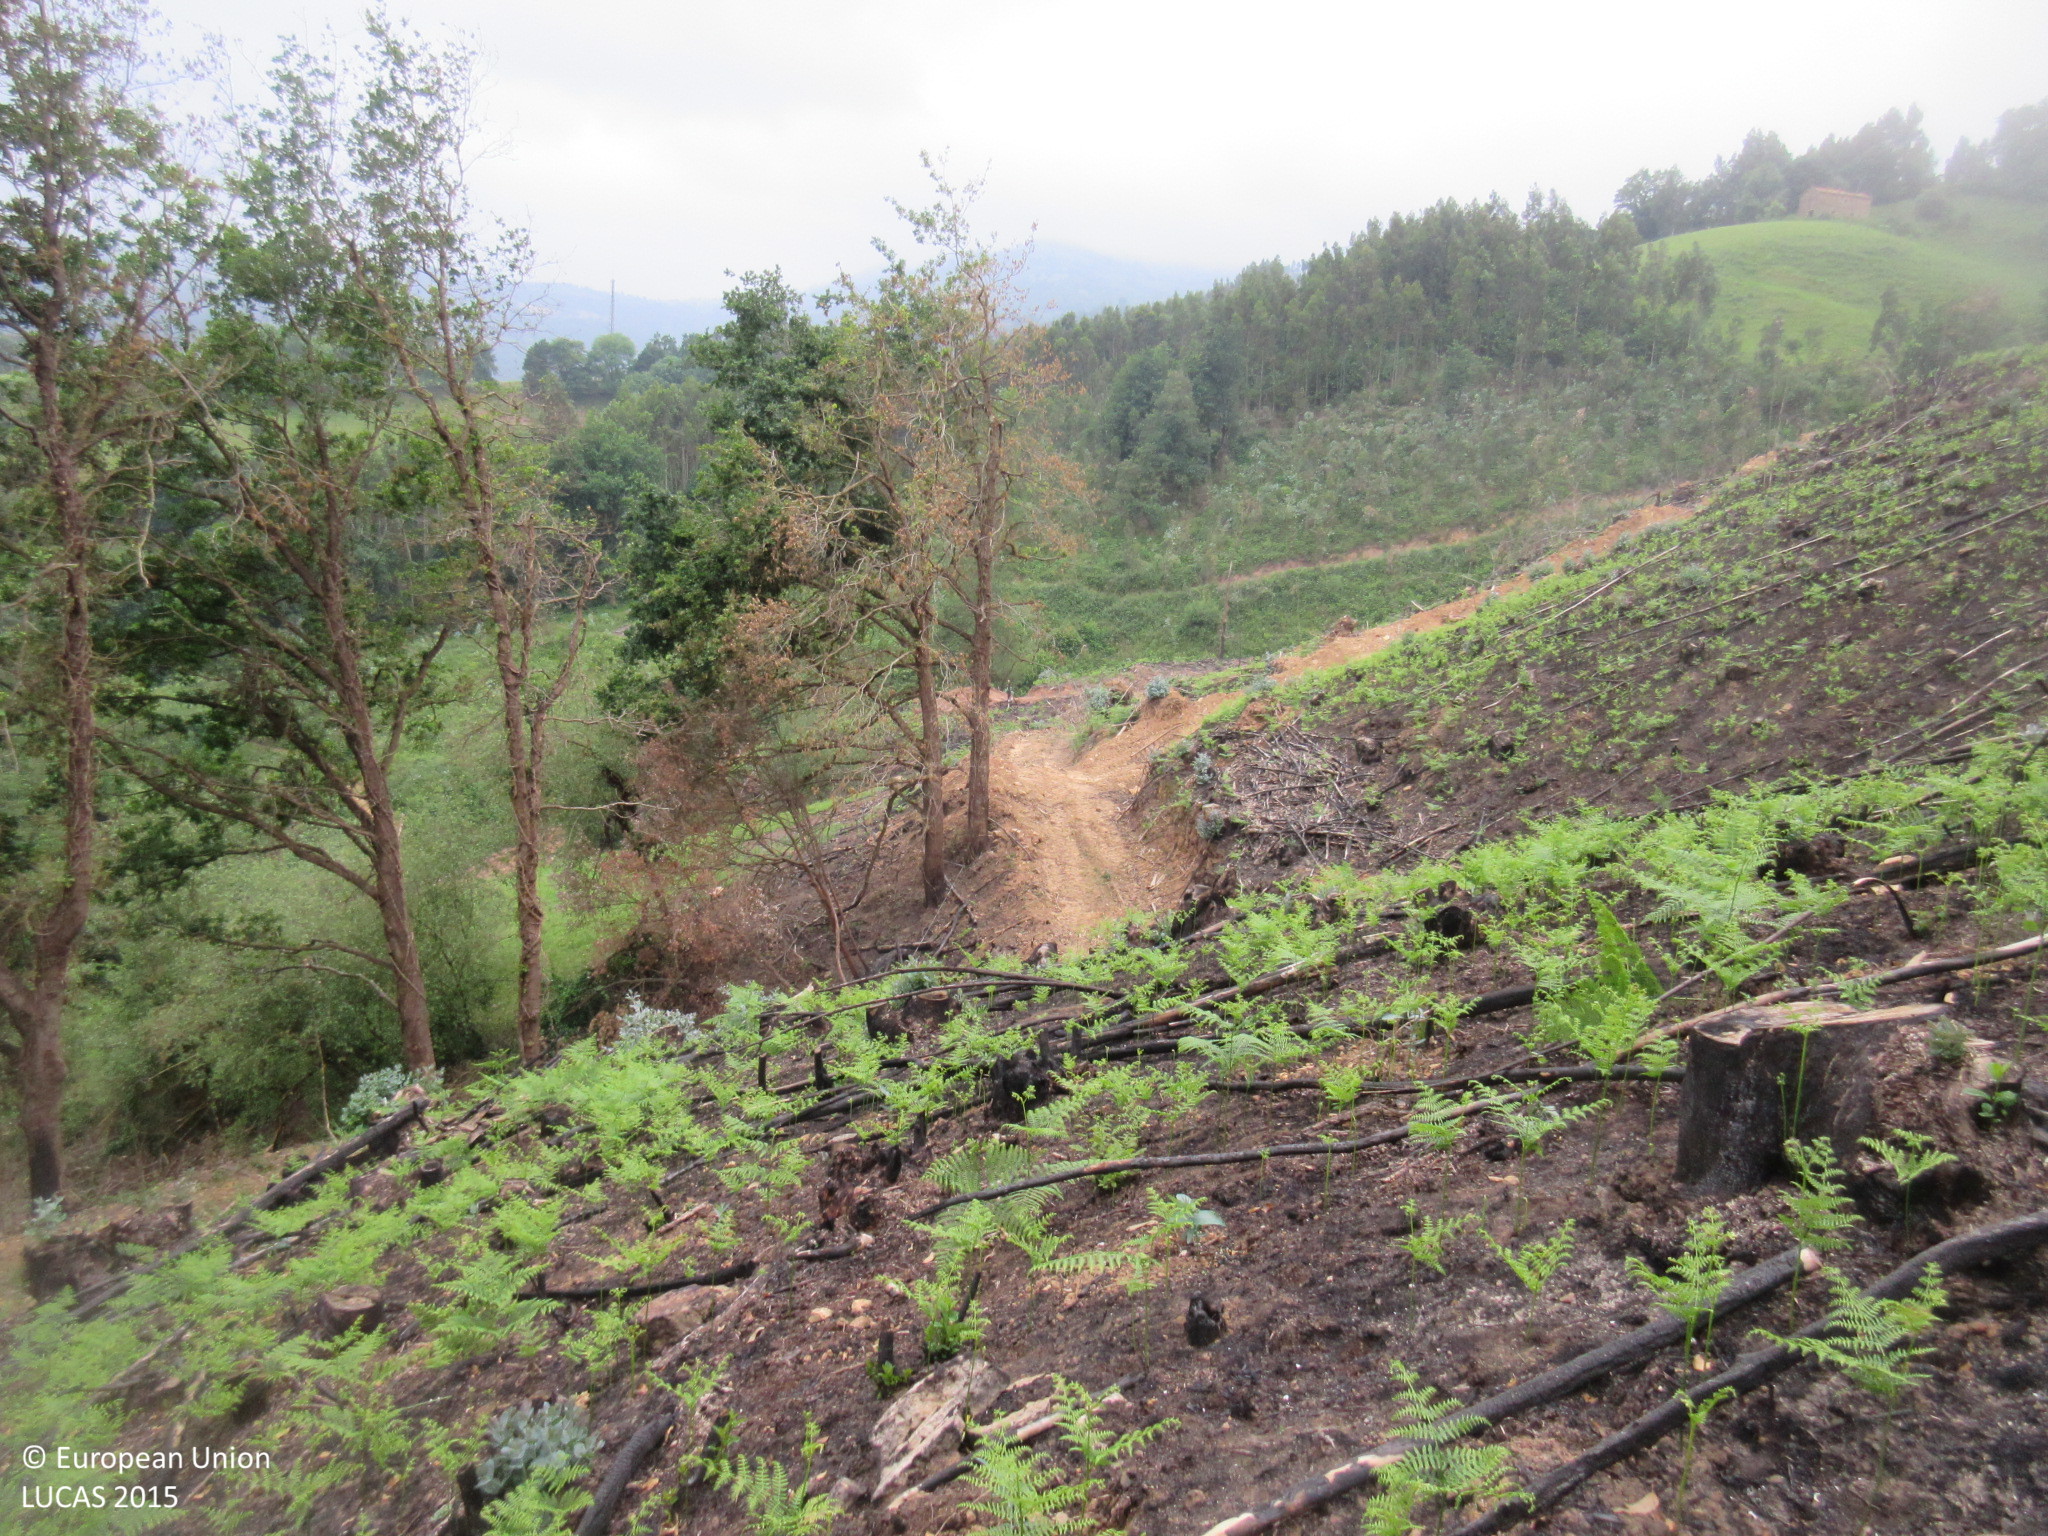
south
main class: Grassland
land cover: Grassland without tree/shrub cover
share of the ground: 25 - 50 %
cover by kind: unconsolidated bare surface 70 %, herbaceous plants 30 %
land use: Semi-natural and natural areas not in use
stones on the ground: < 10 %
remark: Burnt area
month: June
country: ES
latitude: 43.3246
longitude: -3.4469
